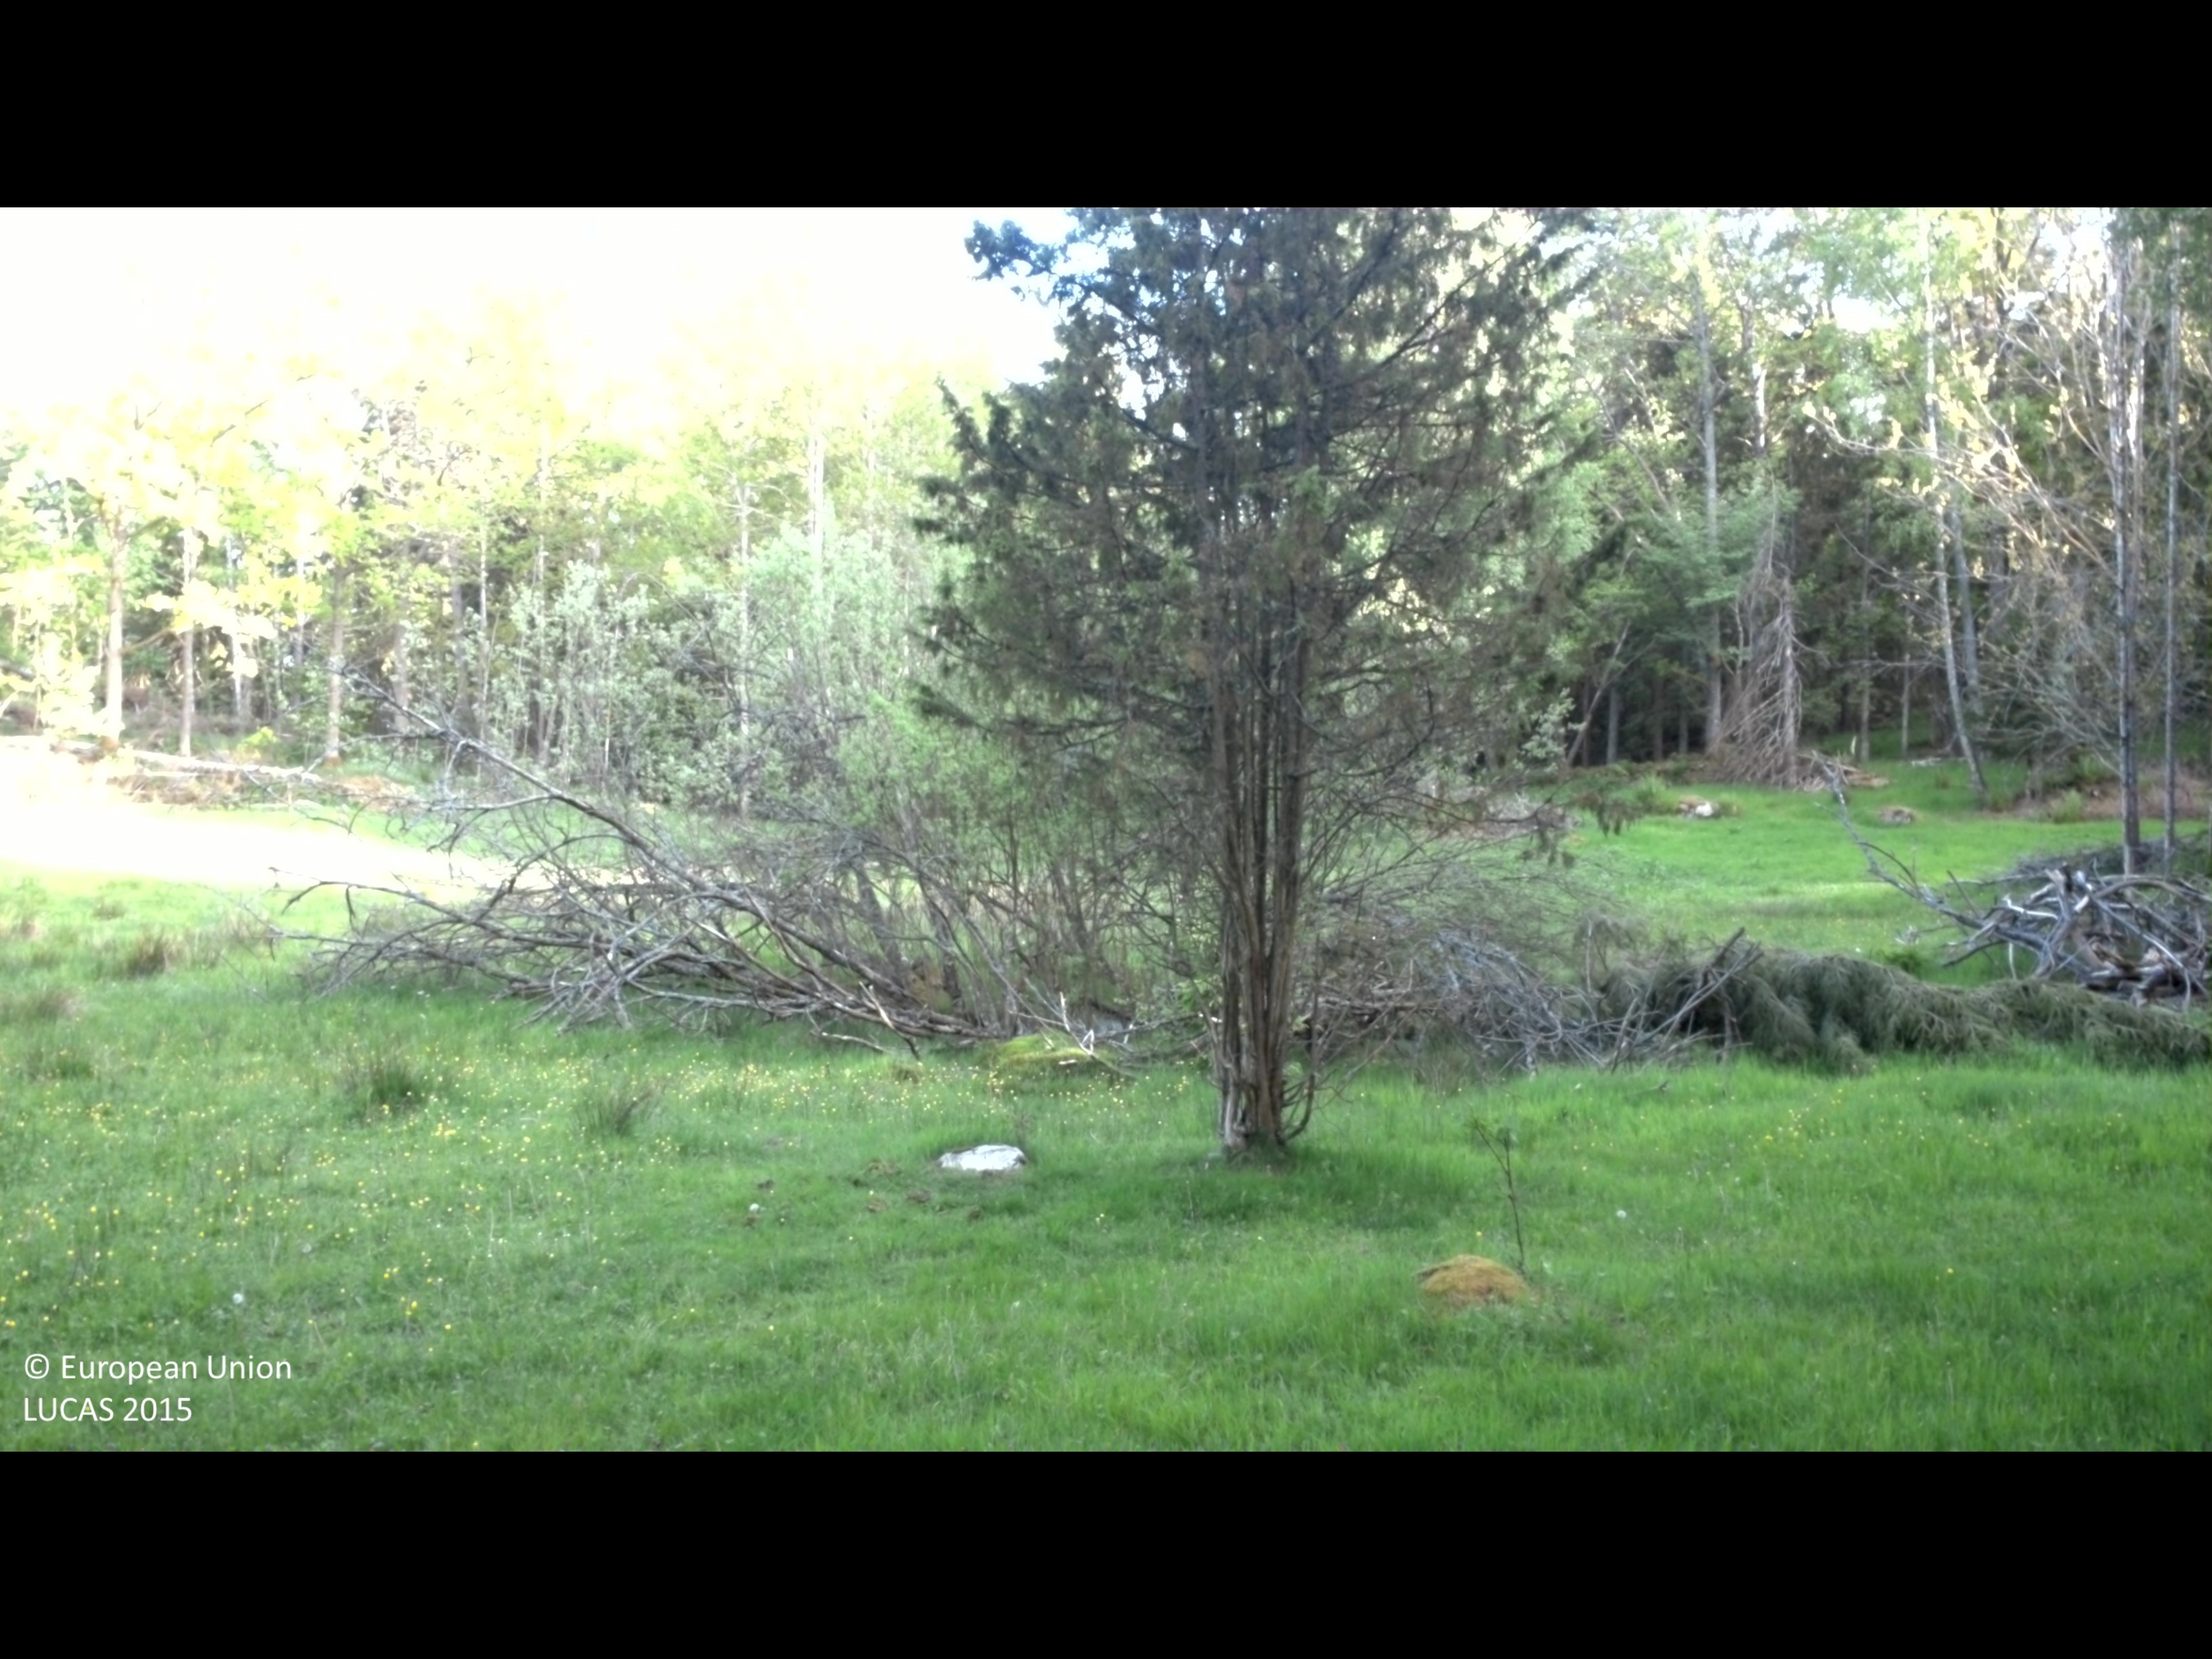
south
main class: Woodland
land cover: Broadleaved woodland
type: hemiboreal forest and nemoral coniferous forest and mixed broadleaved-coniferous forest
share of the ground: 25 - 50 %
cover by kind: broadleaved forest trees 50 %, herbaceous plants 30 %, shrubs 20 %
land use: Agriculture (excluding fallow land and kitchen gardens)
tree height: > 5 m
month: May
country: SE
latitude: 57.2884
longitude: 16.4536
